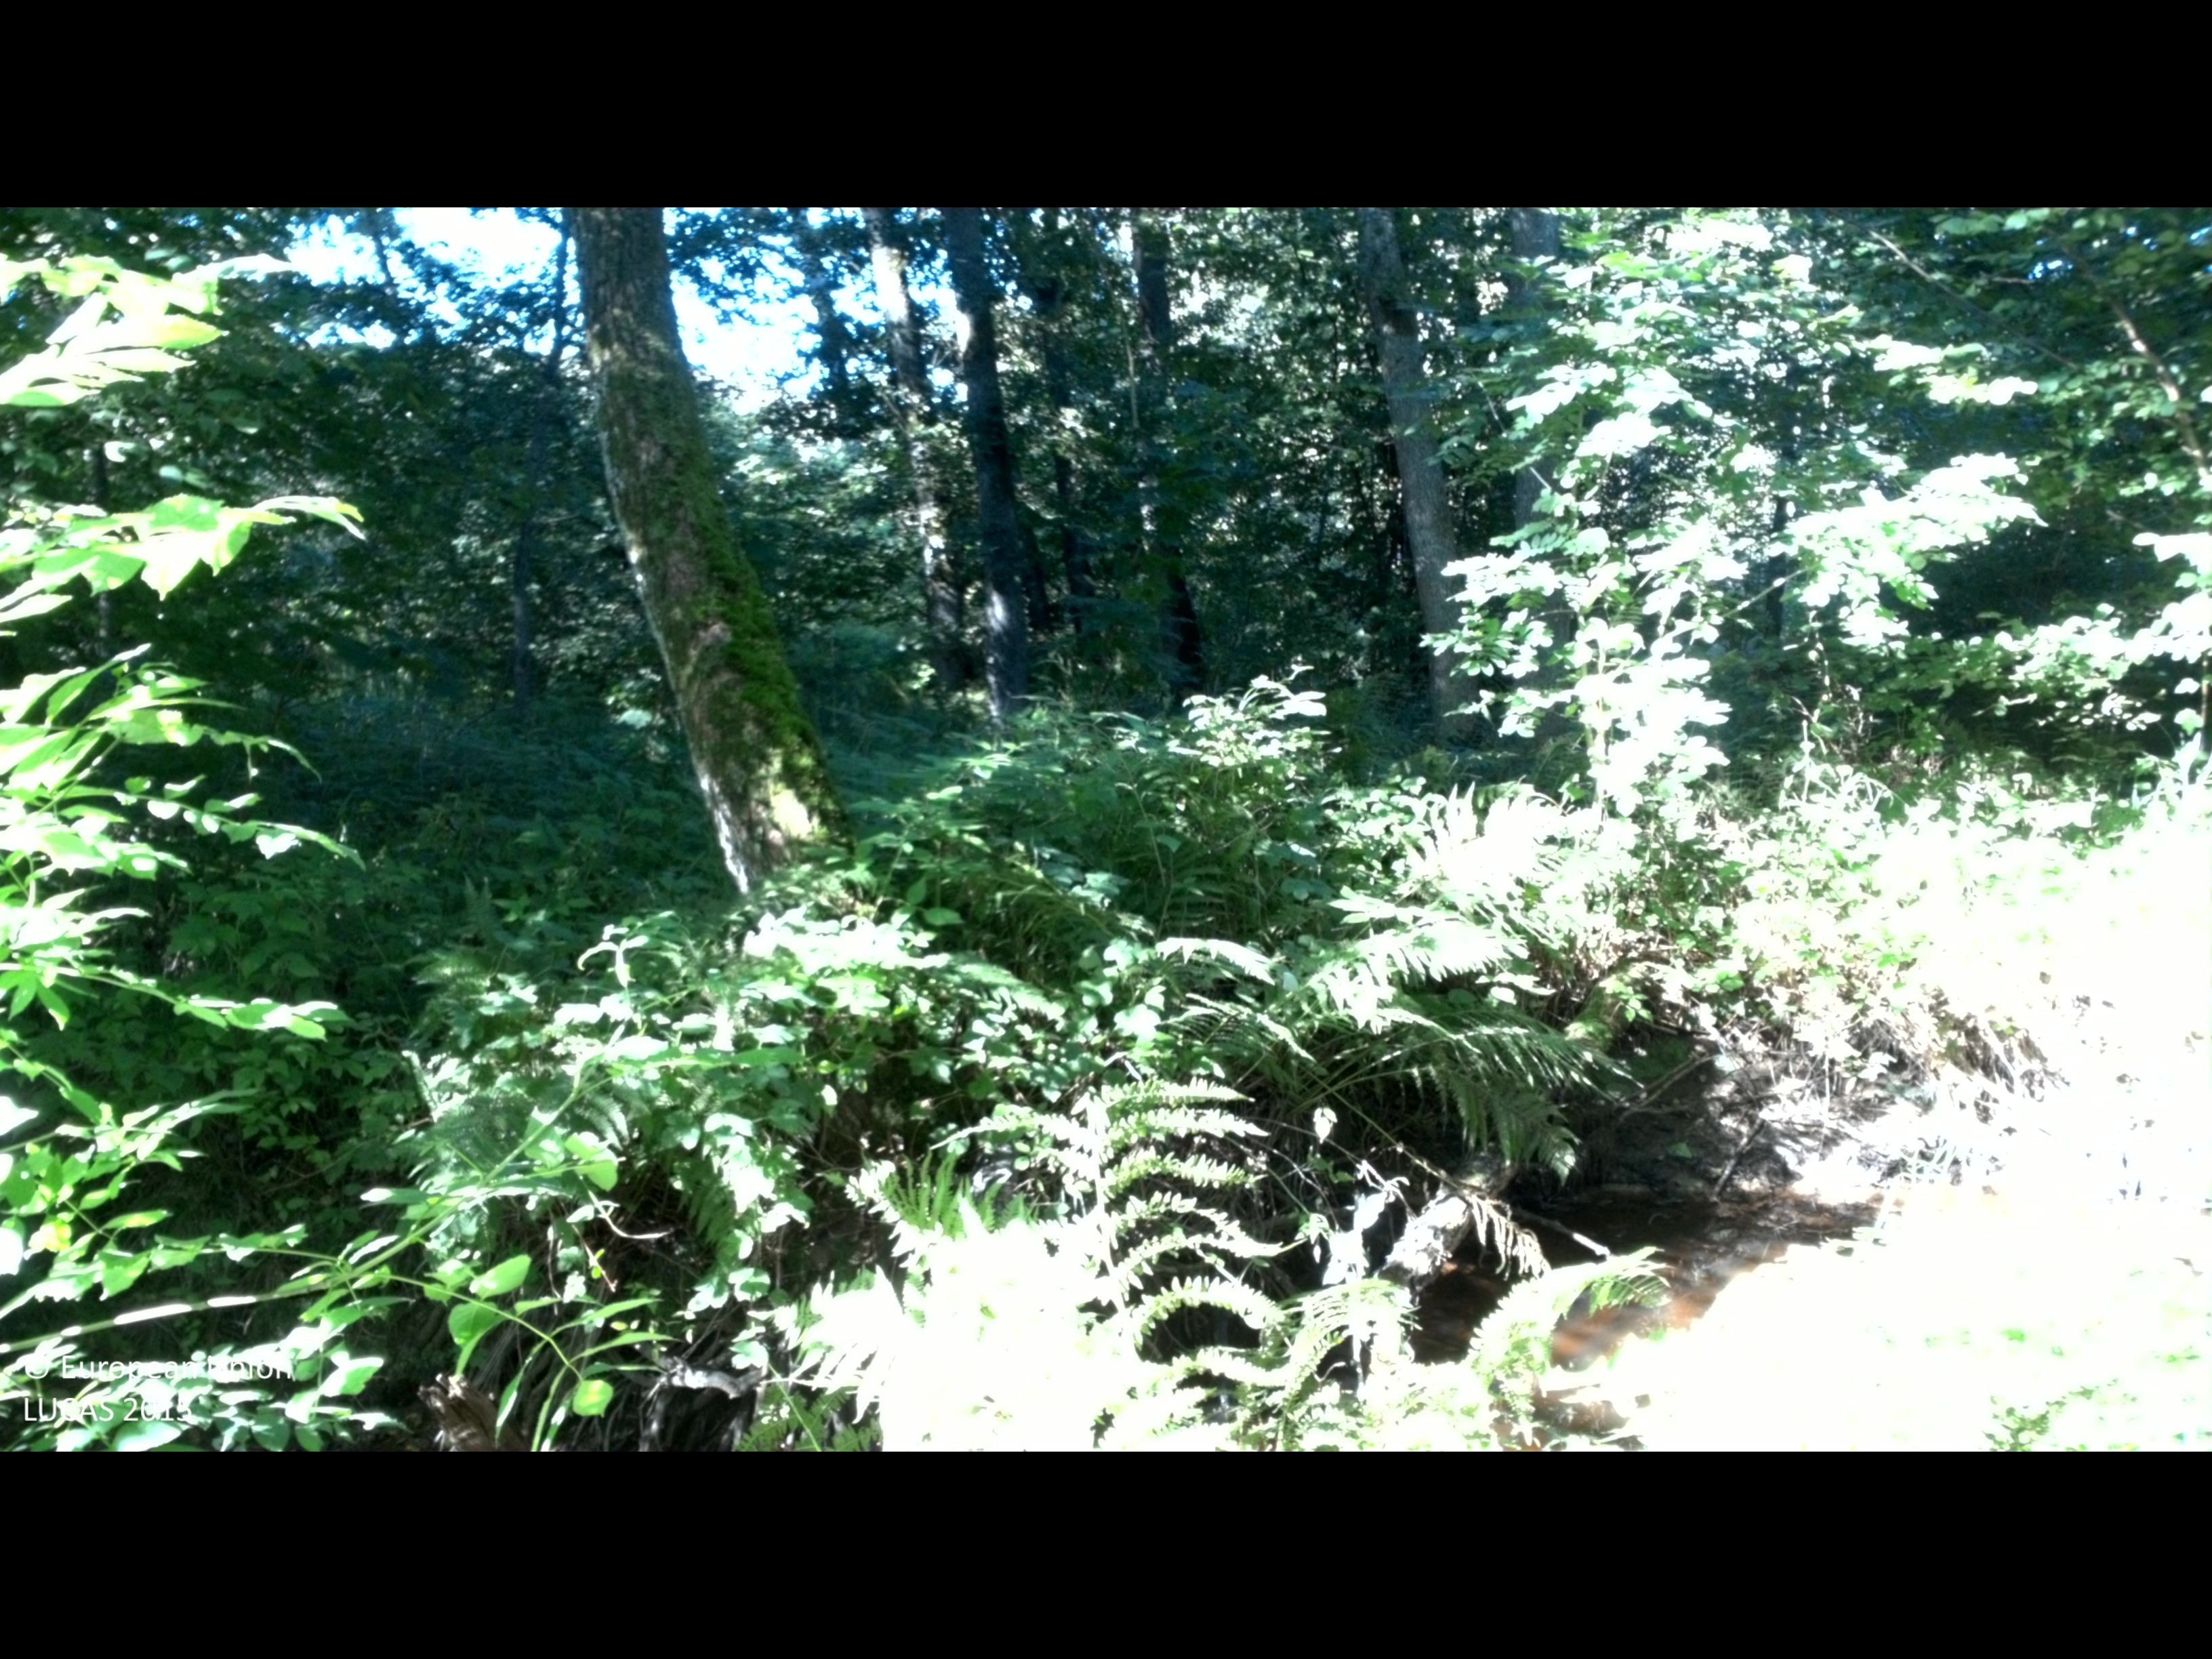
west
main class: Woodland
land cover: Broadleaved woodland
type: mire and swamp forests
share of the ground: 50 - 75 %
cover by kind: broadleaved forest trees 65 %, shrubs 25 %, herbaceous plants 10 %
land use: Forestry
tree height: > 5 m
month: September
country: SE
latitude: 56.1856
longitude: 14.3643
